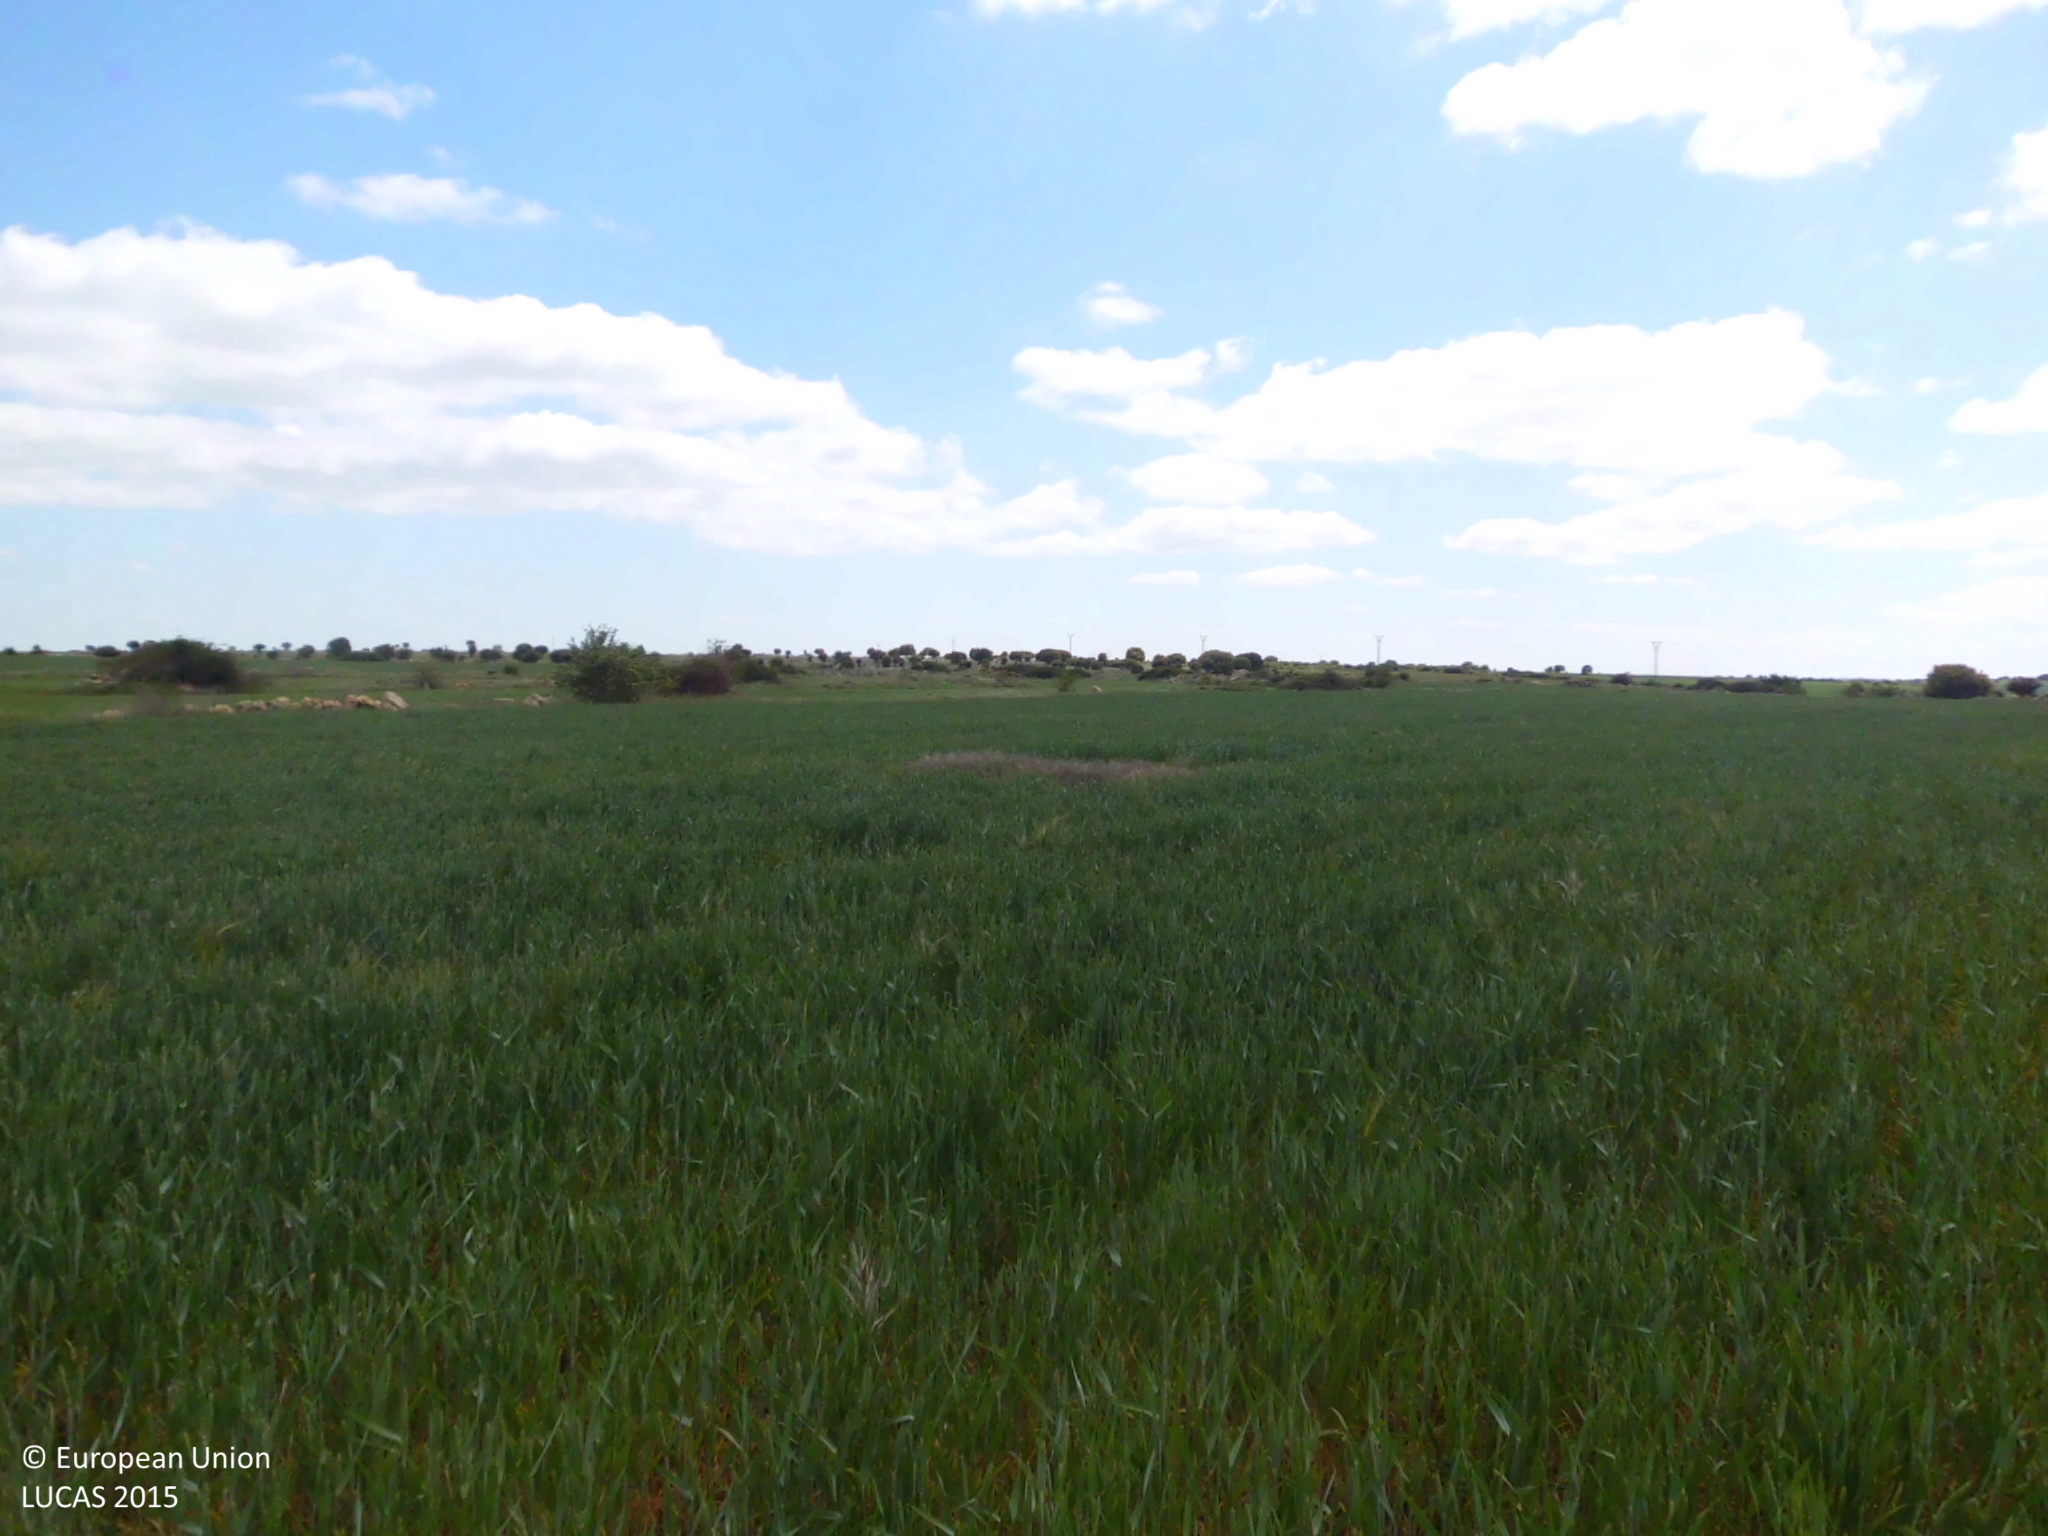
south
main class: Cropland
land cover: Common wheat
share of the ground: > 75 %
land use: Agriculture (excluding fallow land and kitchen gardens)
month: May
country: ES
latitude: 42.4112
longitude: -3.9789
